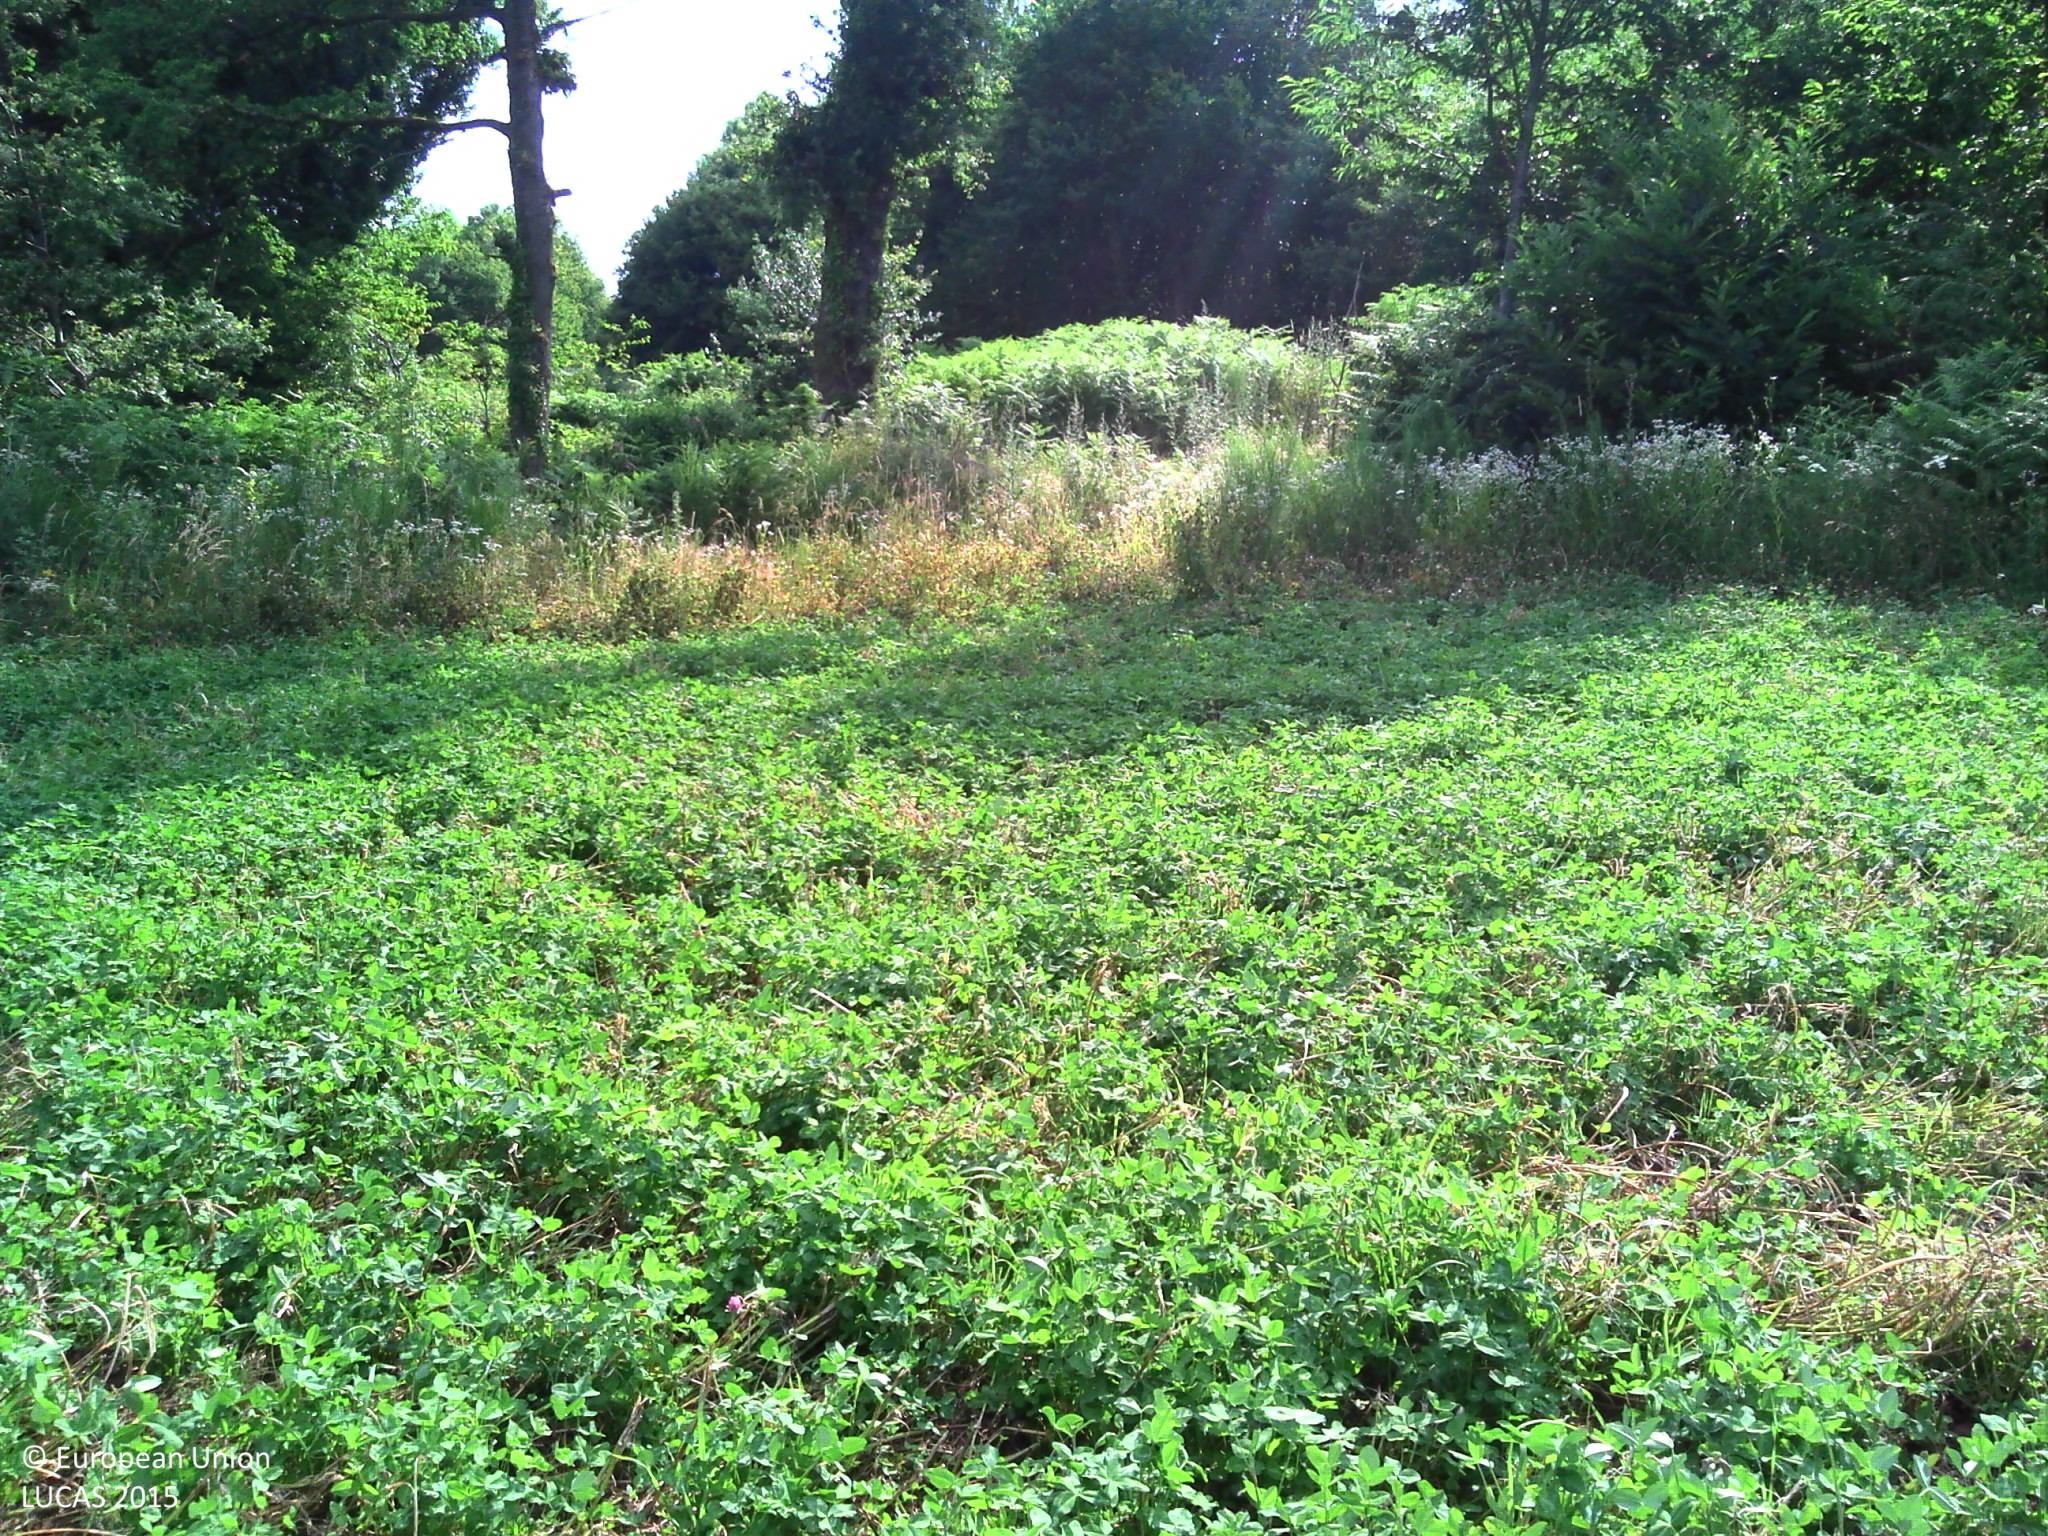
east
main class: Cropland
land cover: Clovers
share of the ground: > 75 %
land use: Agriculture (excluding fallow land and kitchen gardens)
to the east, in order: Clovers; Broadleaved woodland; Grass margins; Paved roads, cycling and walking lanes; Broadleaved woodland; Spontaneously vegetated surfaces; Grass margins; Paved roads, cycling and walking lanes; Broadleaved woodland; Shrubland without tree cover
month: July
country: FR
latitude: 46.0940
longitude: 1.3892
